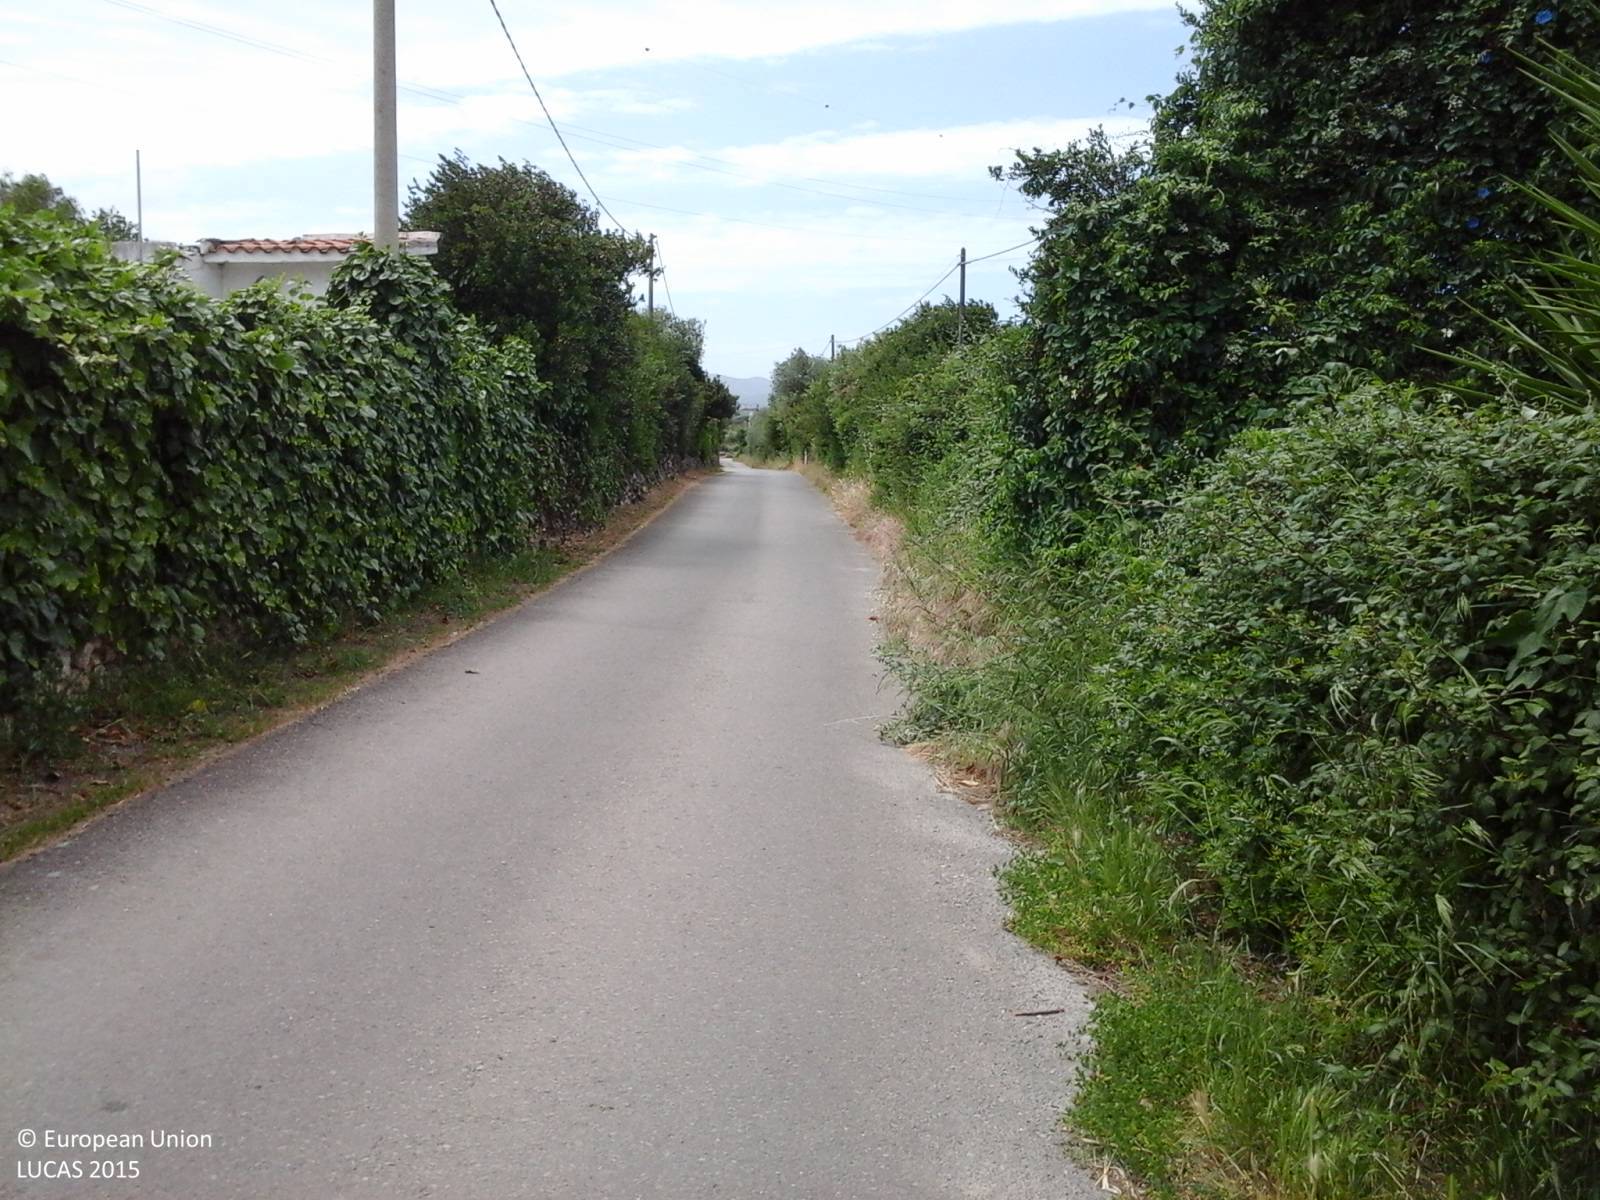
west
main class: Cropland
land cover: Olive groves
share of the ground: < 10 %
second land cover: Tomatoes
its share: < 10 %
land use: Kitchen garden
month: May
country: IT
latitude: 40.7443
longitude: 8.4796
